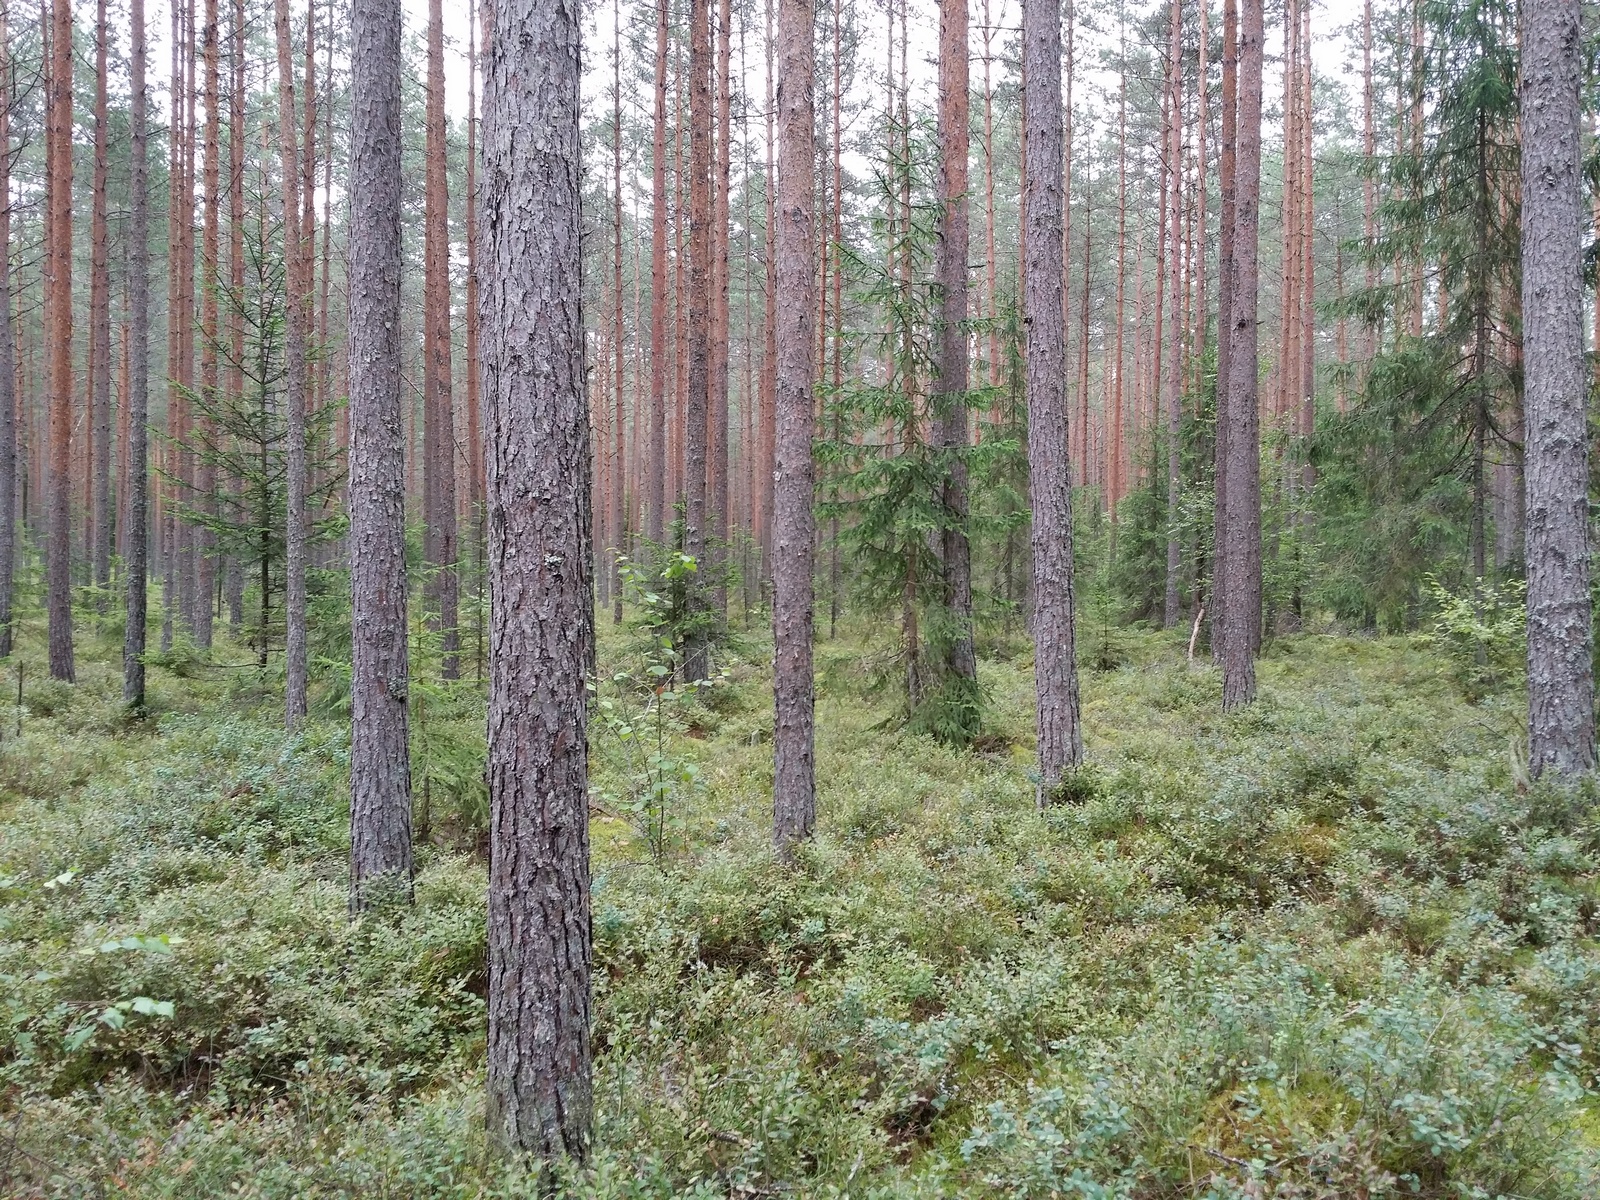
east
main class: Woodland
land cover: Other coniferous woodland
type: hemiboreal forest and nemoral coniferous forest and mixed broadleaved-coniferous forest
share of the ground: > 75 %
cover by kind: coniferous forest trees 85 %, lichens and mosses 15 %
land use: Forestry
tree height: > 5 m
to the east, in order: Other coniferous woodland; Tracks; Other coniferous woodland
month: August
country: LV
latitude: 57.2580
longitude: 26.6771
